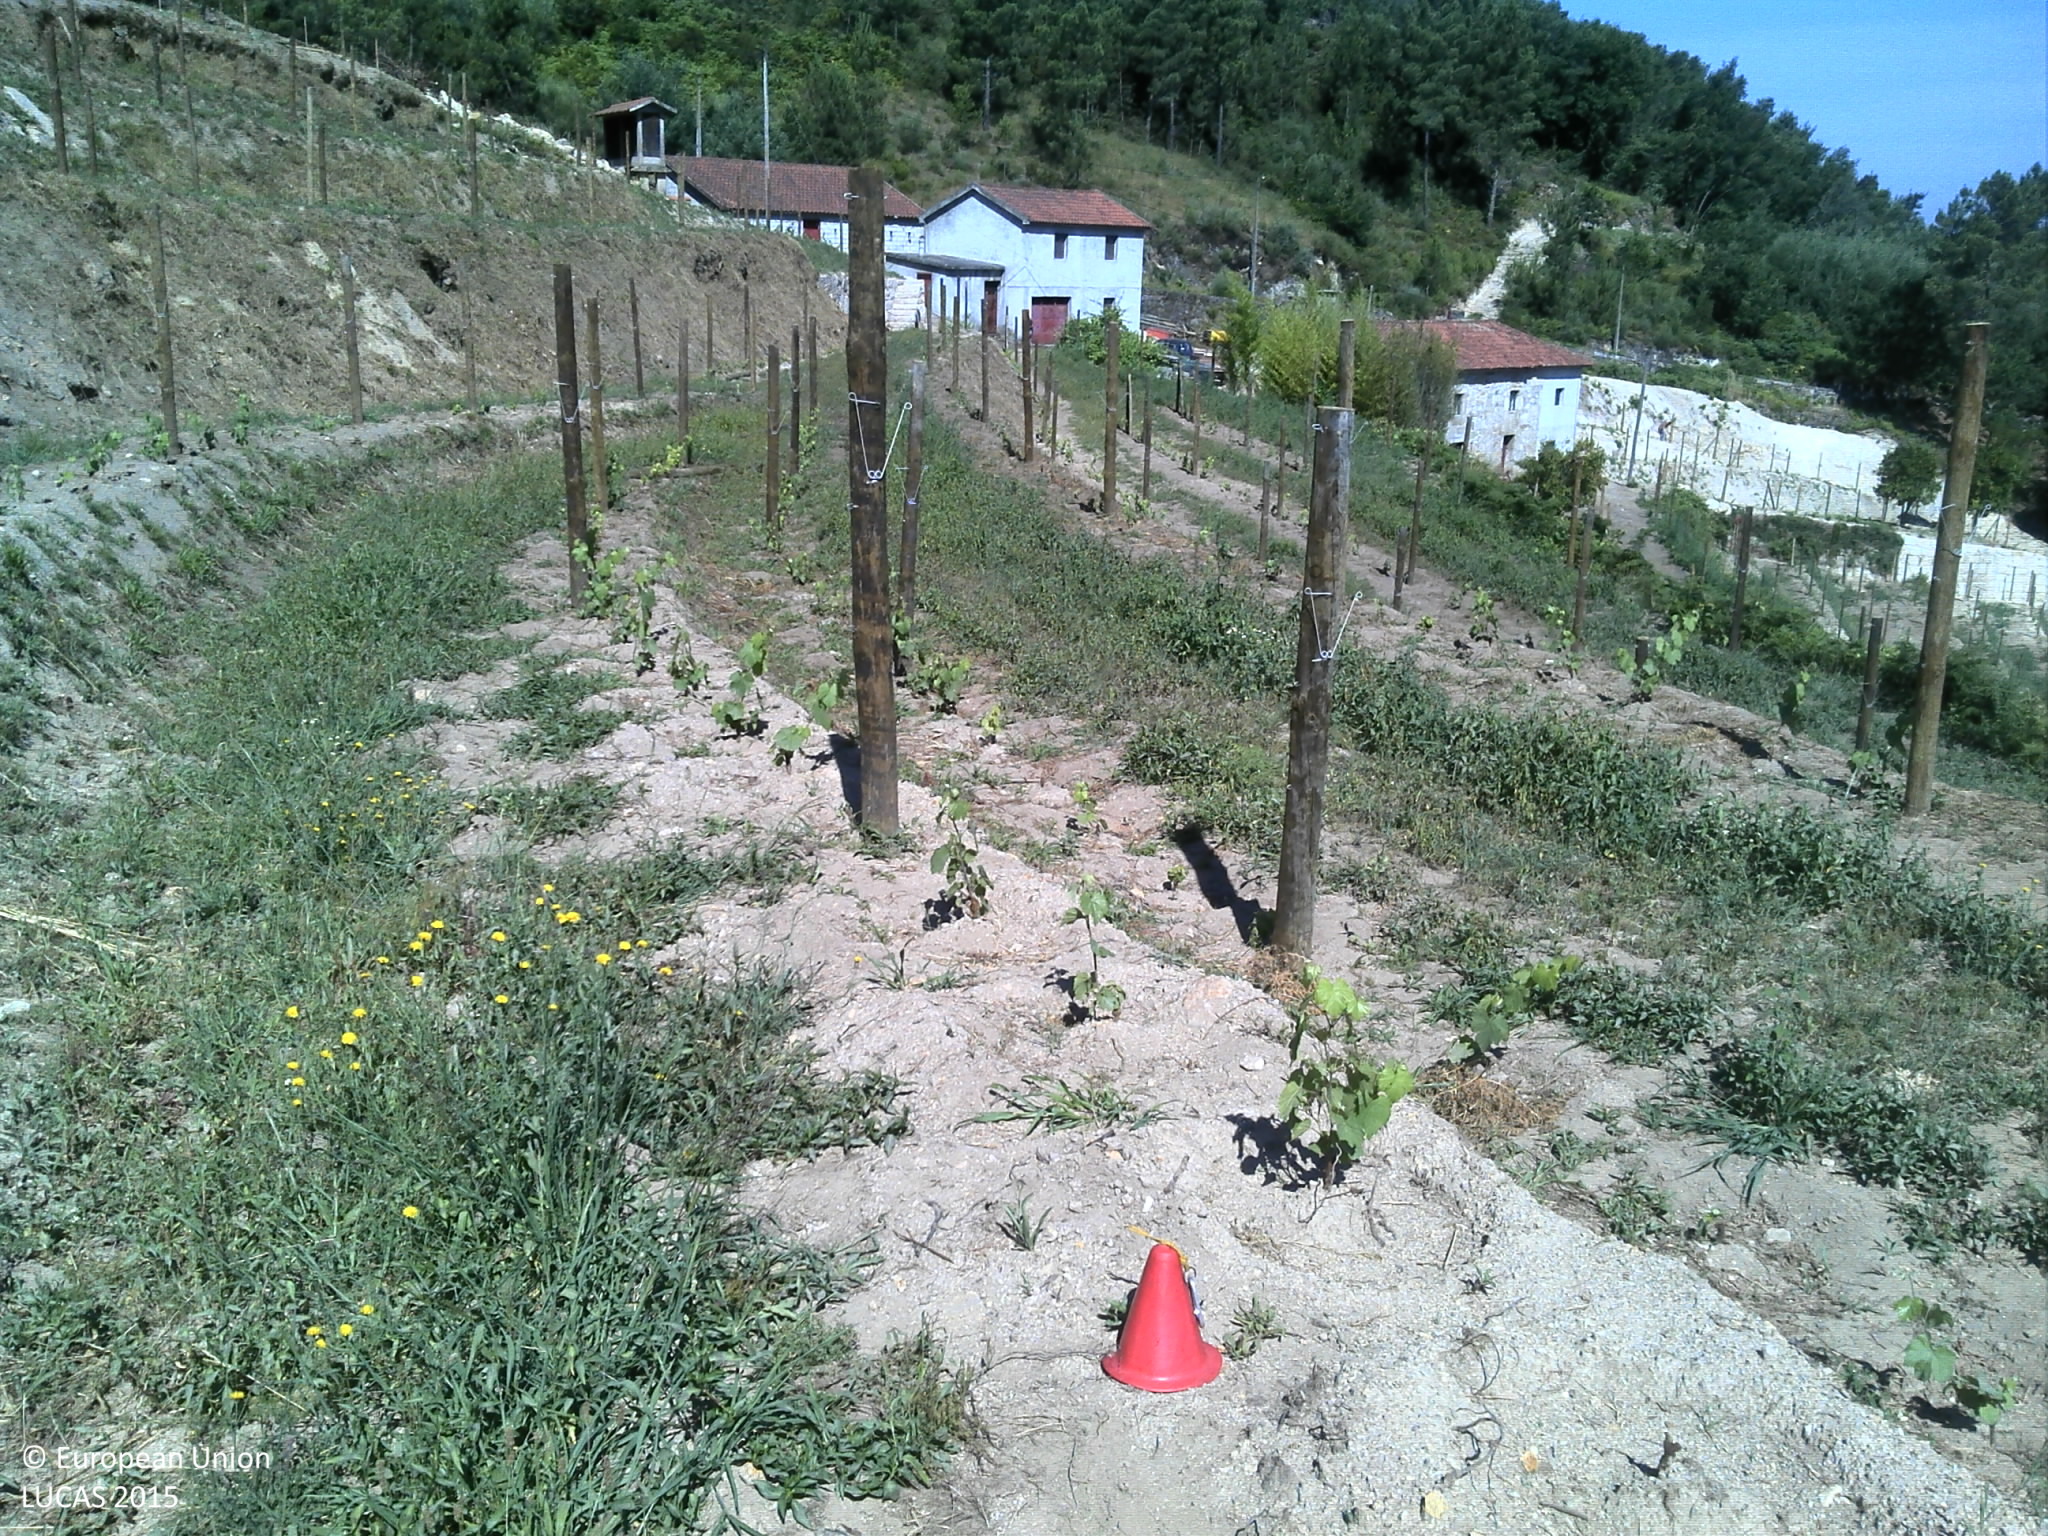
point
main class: Cropland
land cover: Vineyards
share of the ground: < 10 %
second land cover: Grassland without tree/shrub cover
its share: 25 - 50 %
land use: Agriculture (excluding fallow land and kitchen gardens)
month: July
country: PT
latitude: 41.4605
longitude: -7.8427
